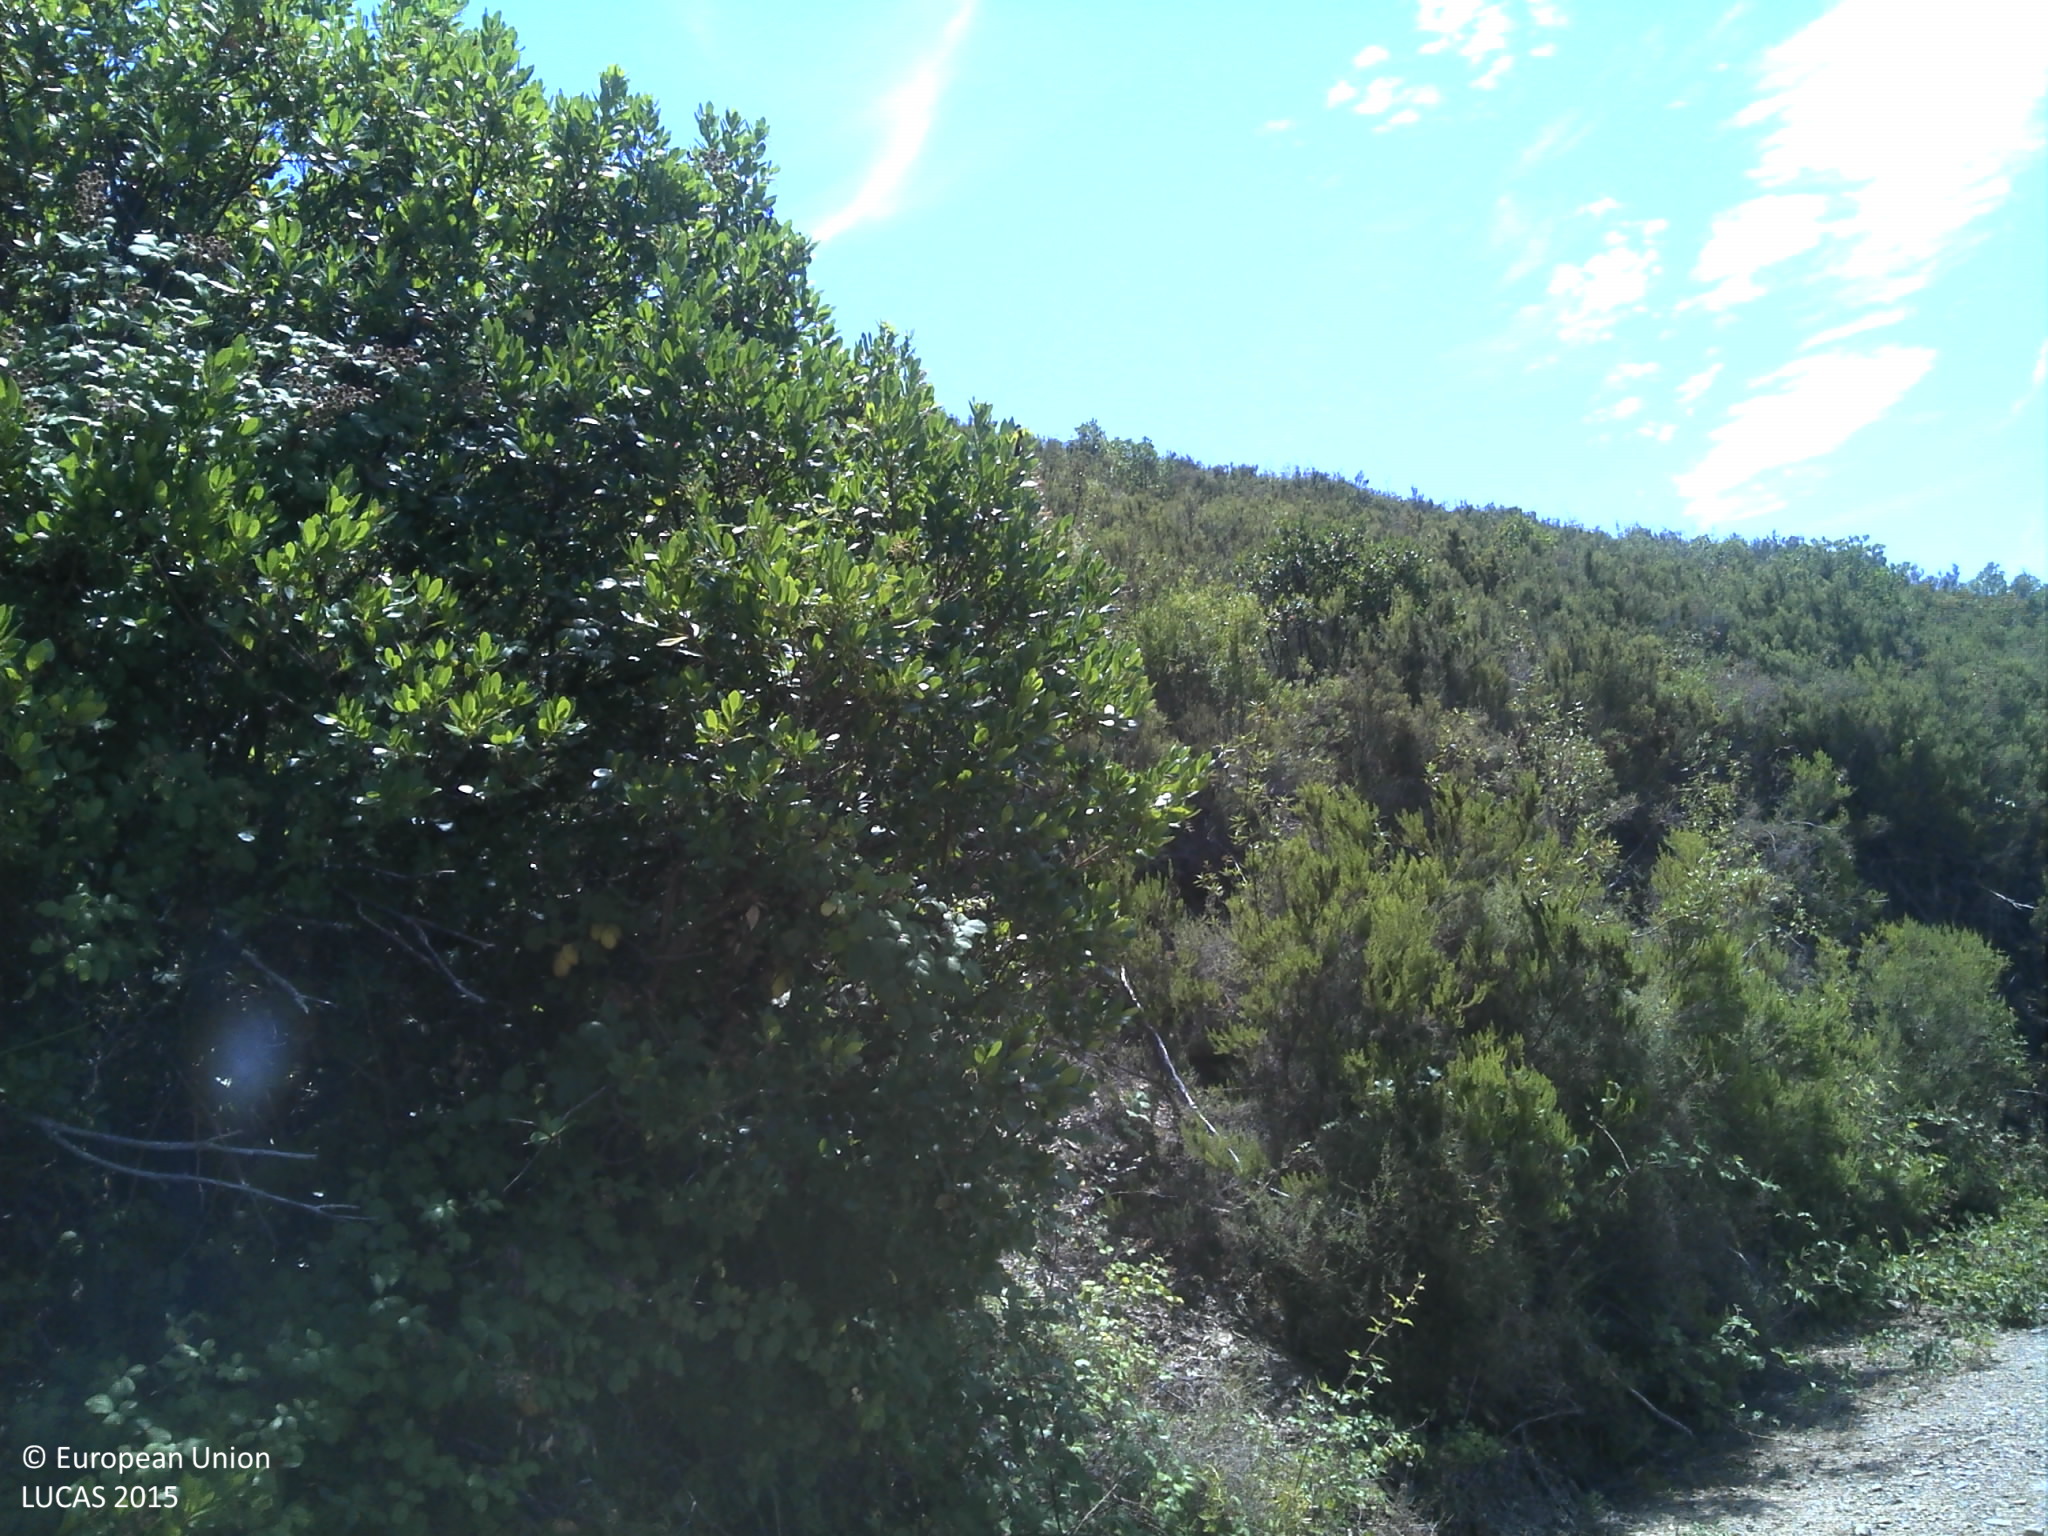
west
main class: Shrubland
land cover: Shrubland without tree cover
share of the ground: > 75 %
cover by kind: shrubs 90 %, unconsolidated bare surface 10 %
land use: Abandoned areas
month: July
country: PT
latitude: 40.0613
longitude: -7.9225
